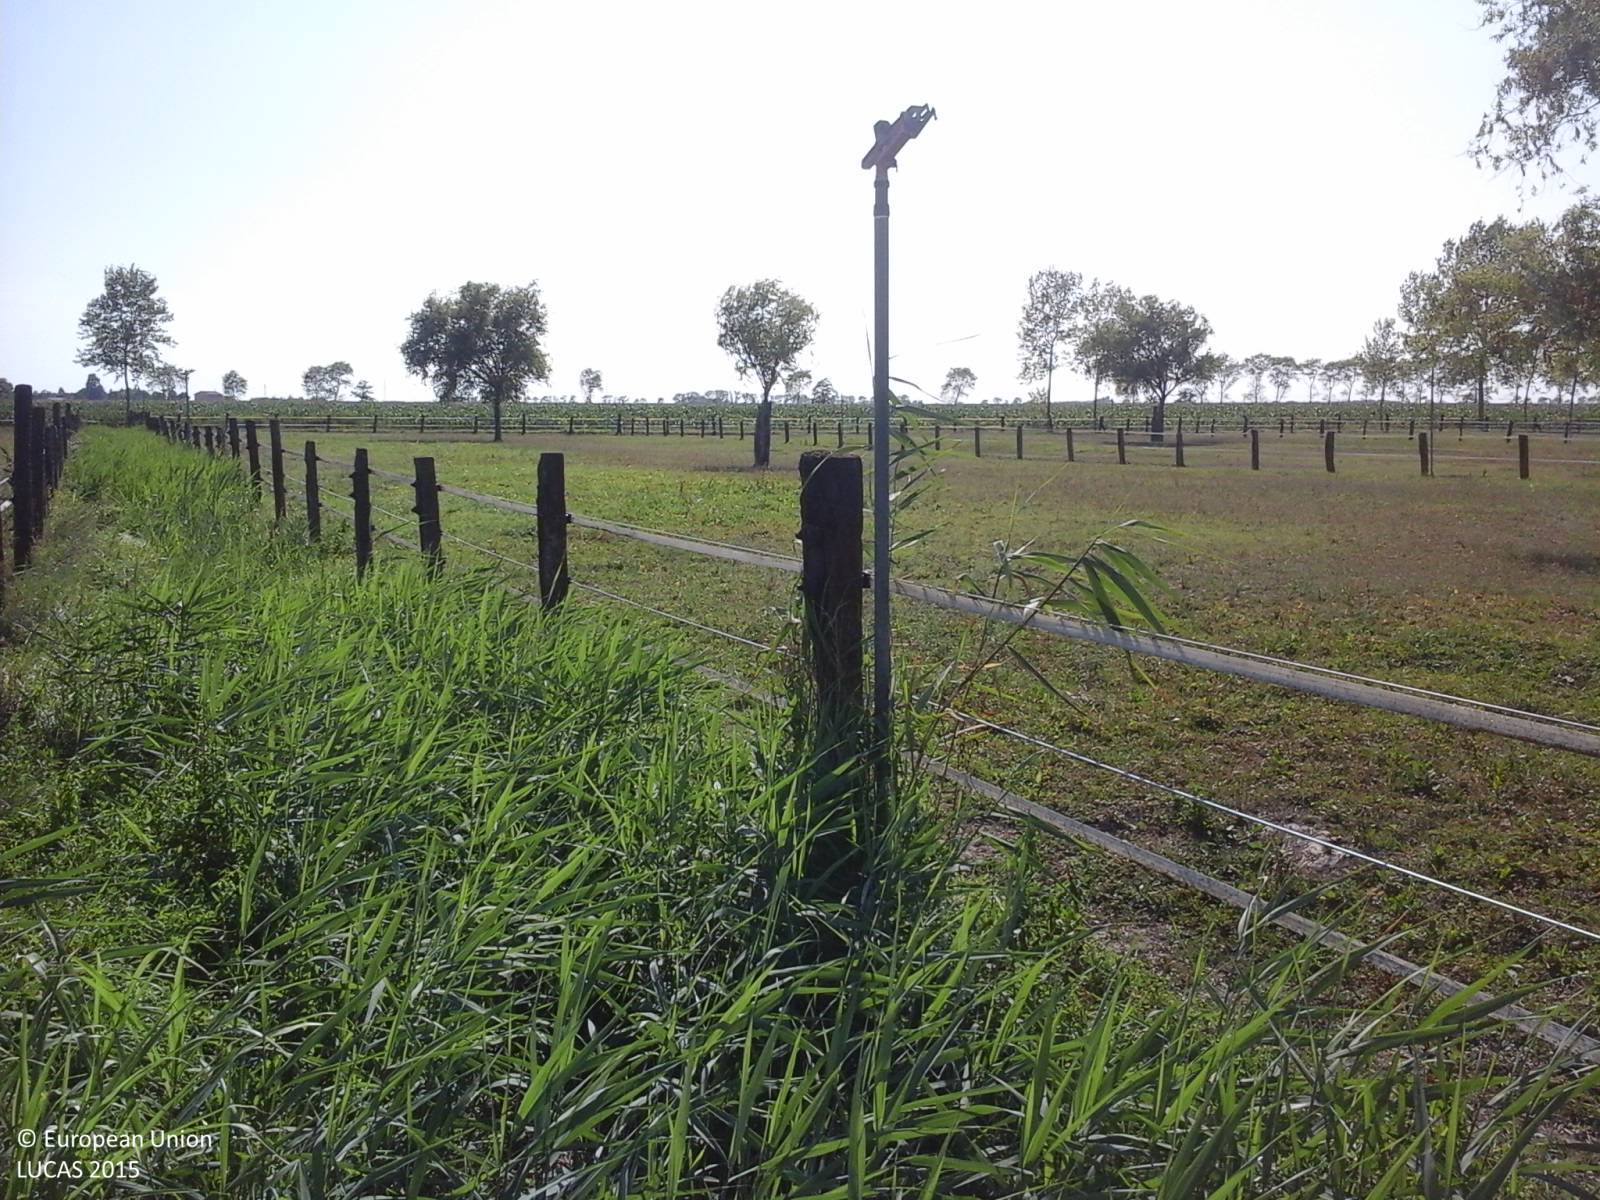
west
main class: Grassland
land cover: Grassland without tree/shrub cover
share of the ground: > 75 %
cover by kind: herbaceous plants 100 %
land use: Agriculture (excluding fallow land and kitchen gardens)
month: July
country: IT
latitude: 45.6771
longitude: 13.0386
